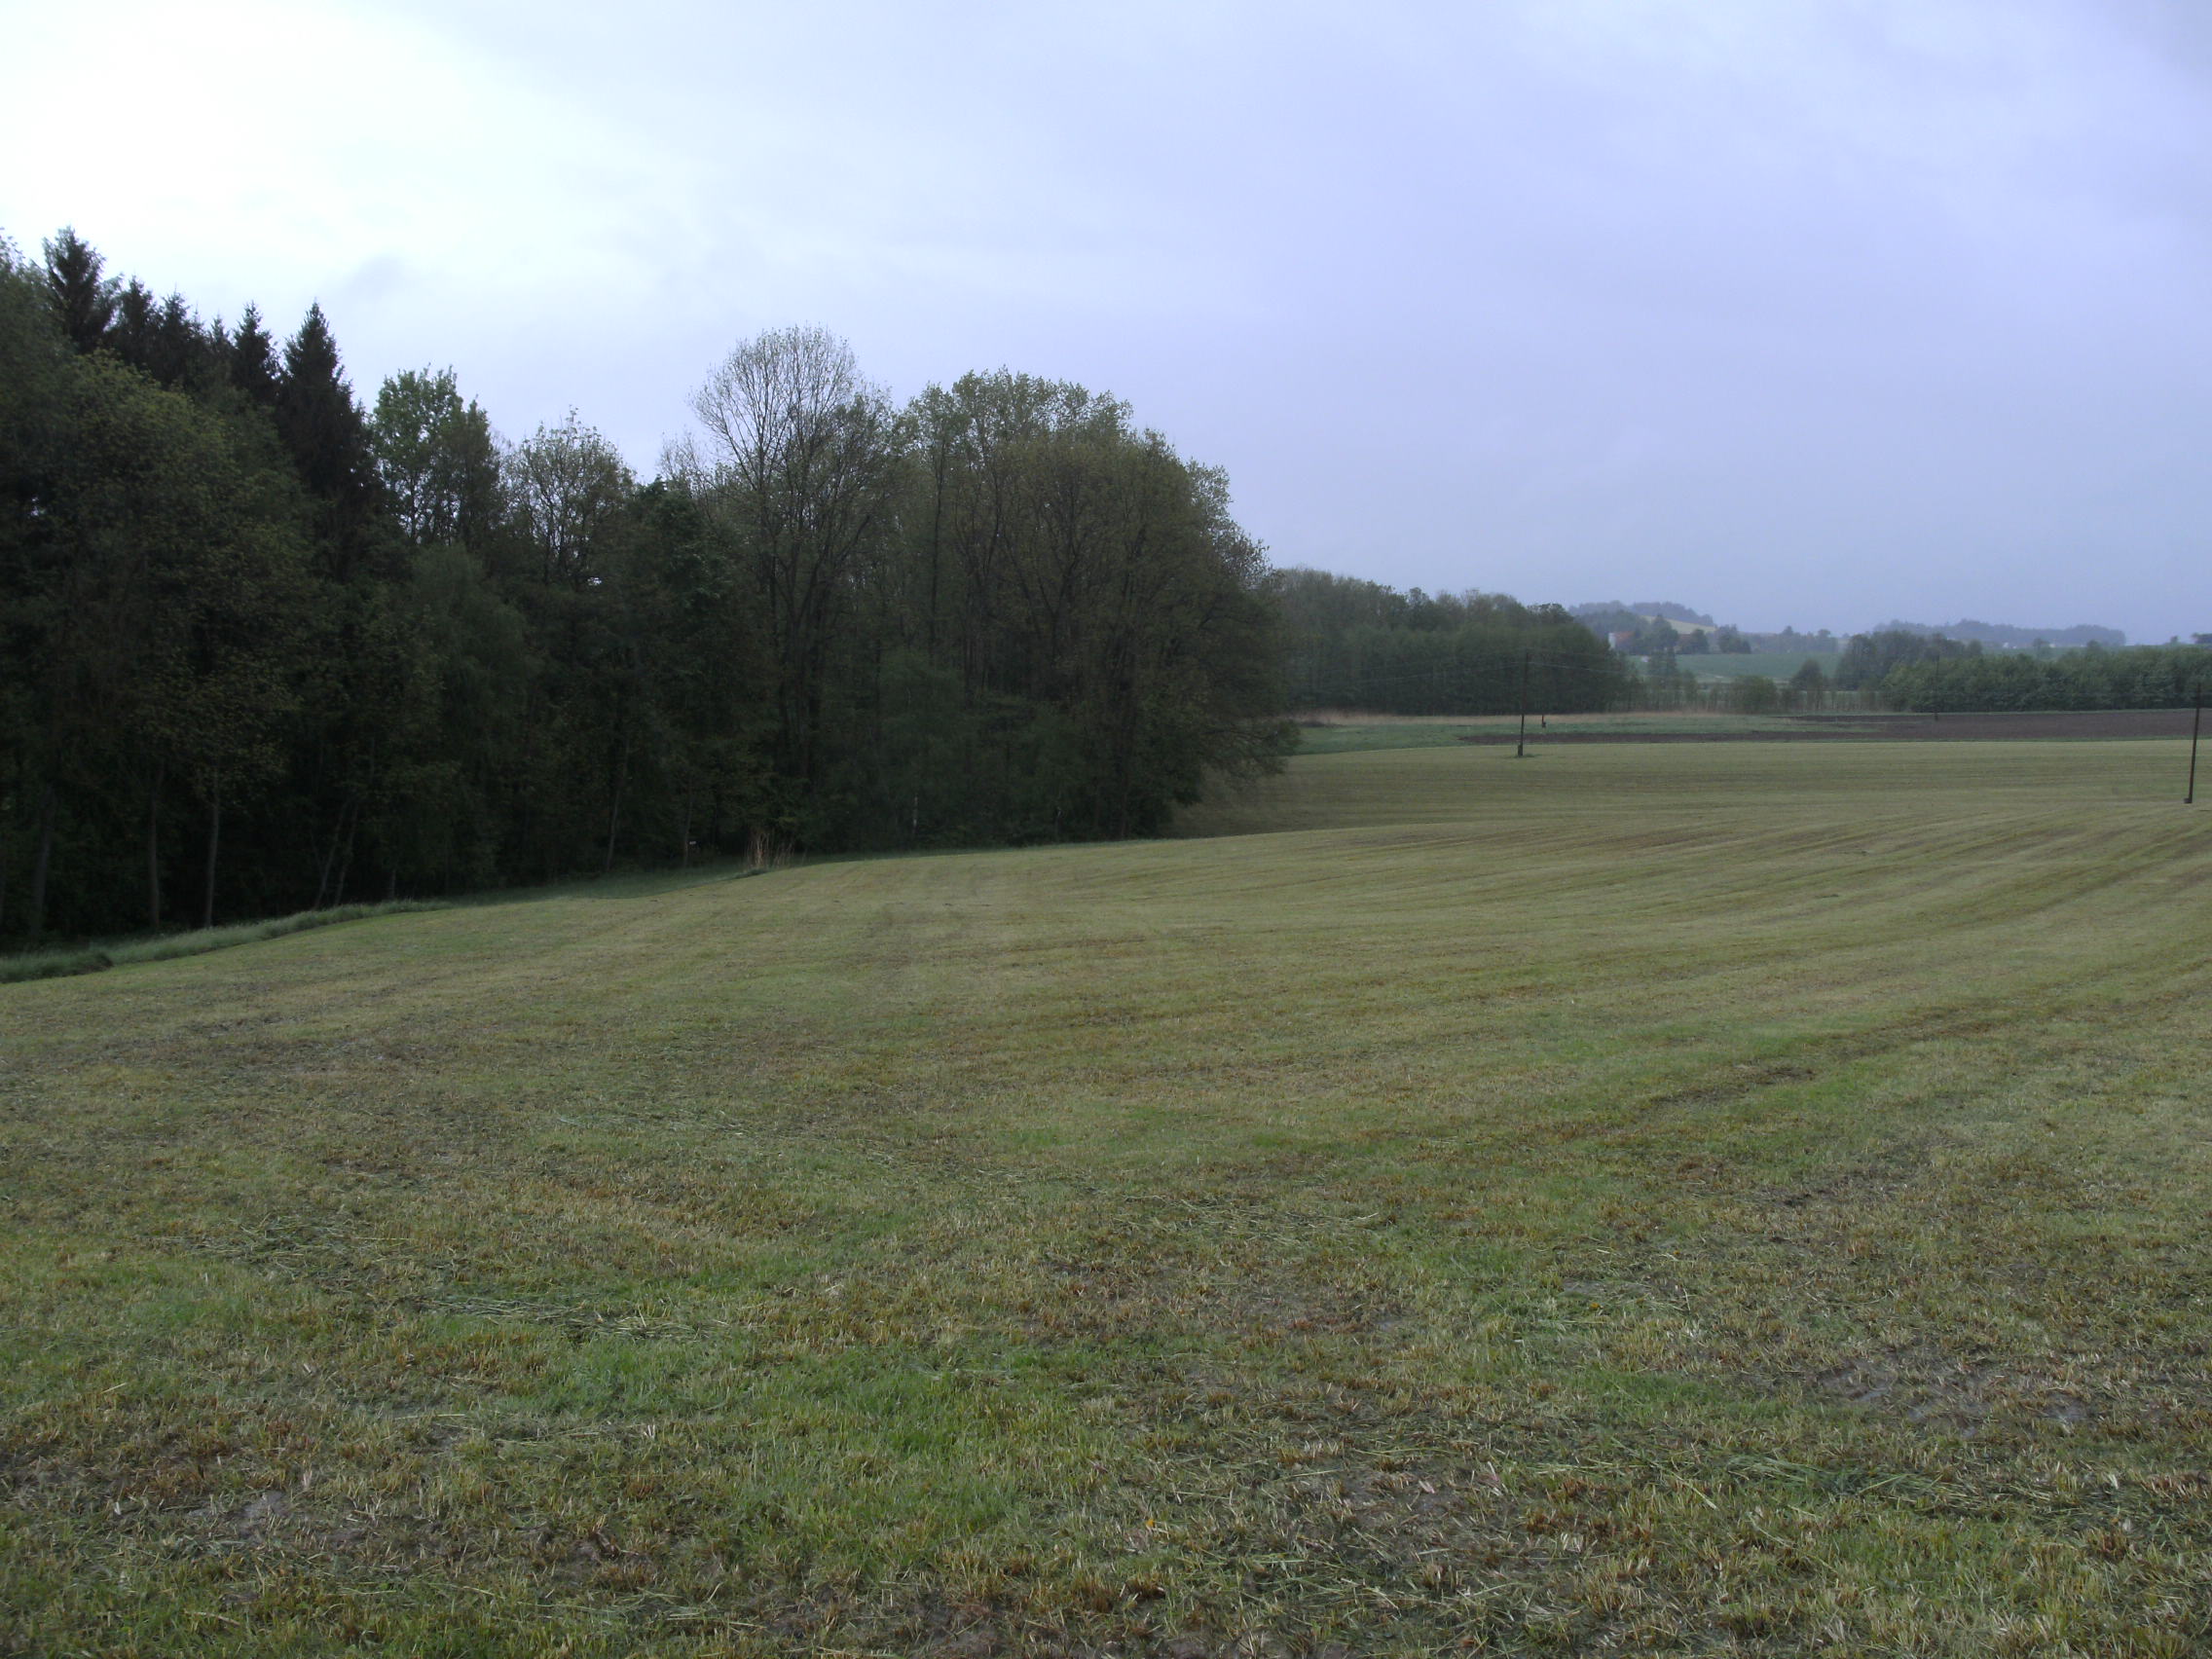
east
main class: Grassland
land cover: Grassland without tree/shrub cover
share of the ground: > 75 %
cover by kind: herbaceous plants 100 %
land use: Agriculture (excluding fallow land and kitchen gardens)
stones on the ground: < 10 %
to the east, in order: Grassland without tree/shrub cover; Ditches and canals; Grassland without tree/shrub cover; Broadleaved woodland; Rivers and streams; Broadleaved woodland; Inland fresh running water; Broadleaved woodland; Inland fresh running water; Broadleaved woodland; Grassland with sparse tree/shrub cover; Electric lines; Grassland with sparse tree/shrub cover
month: May
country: AT
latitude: 48.2259
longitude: 13.3780
